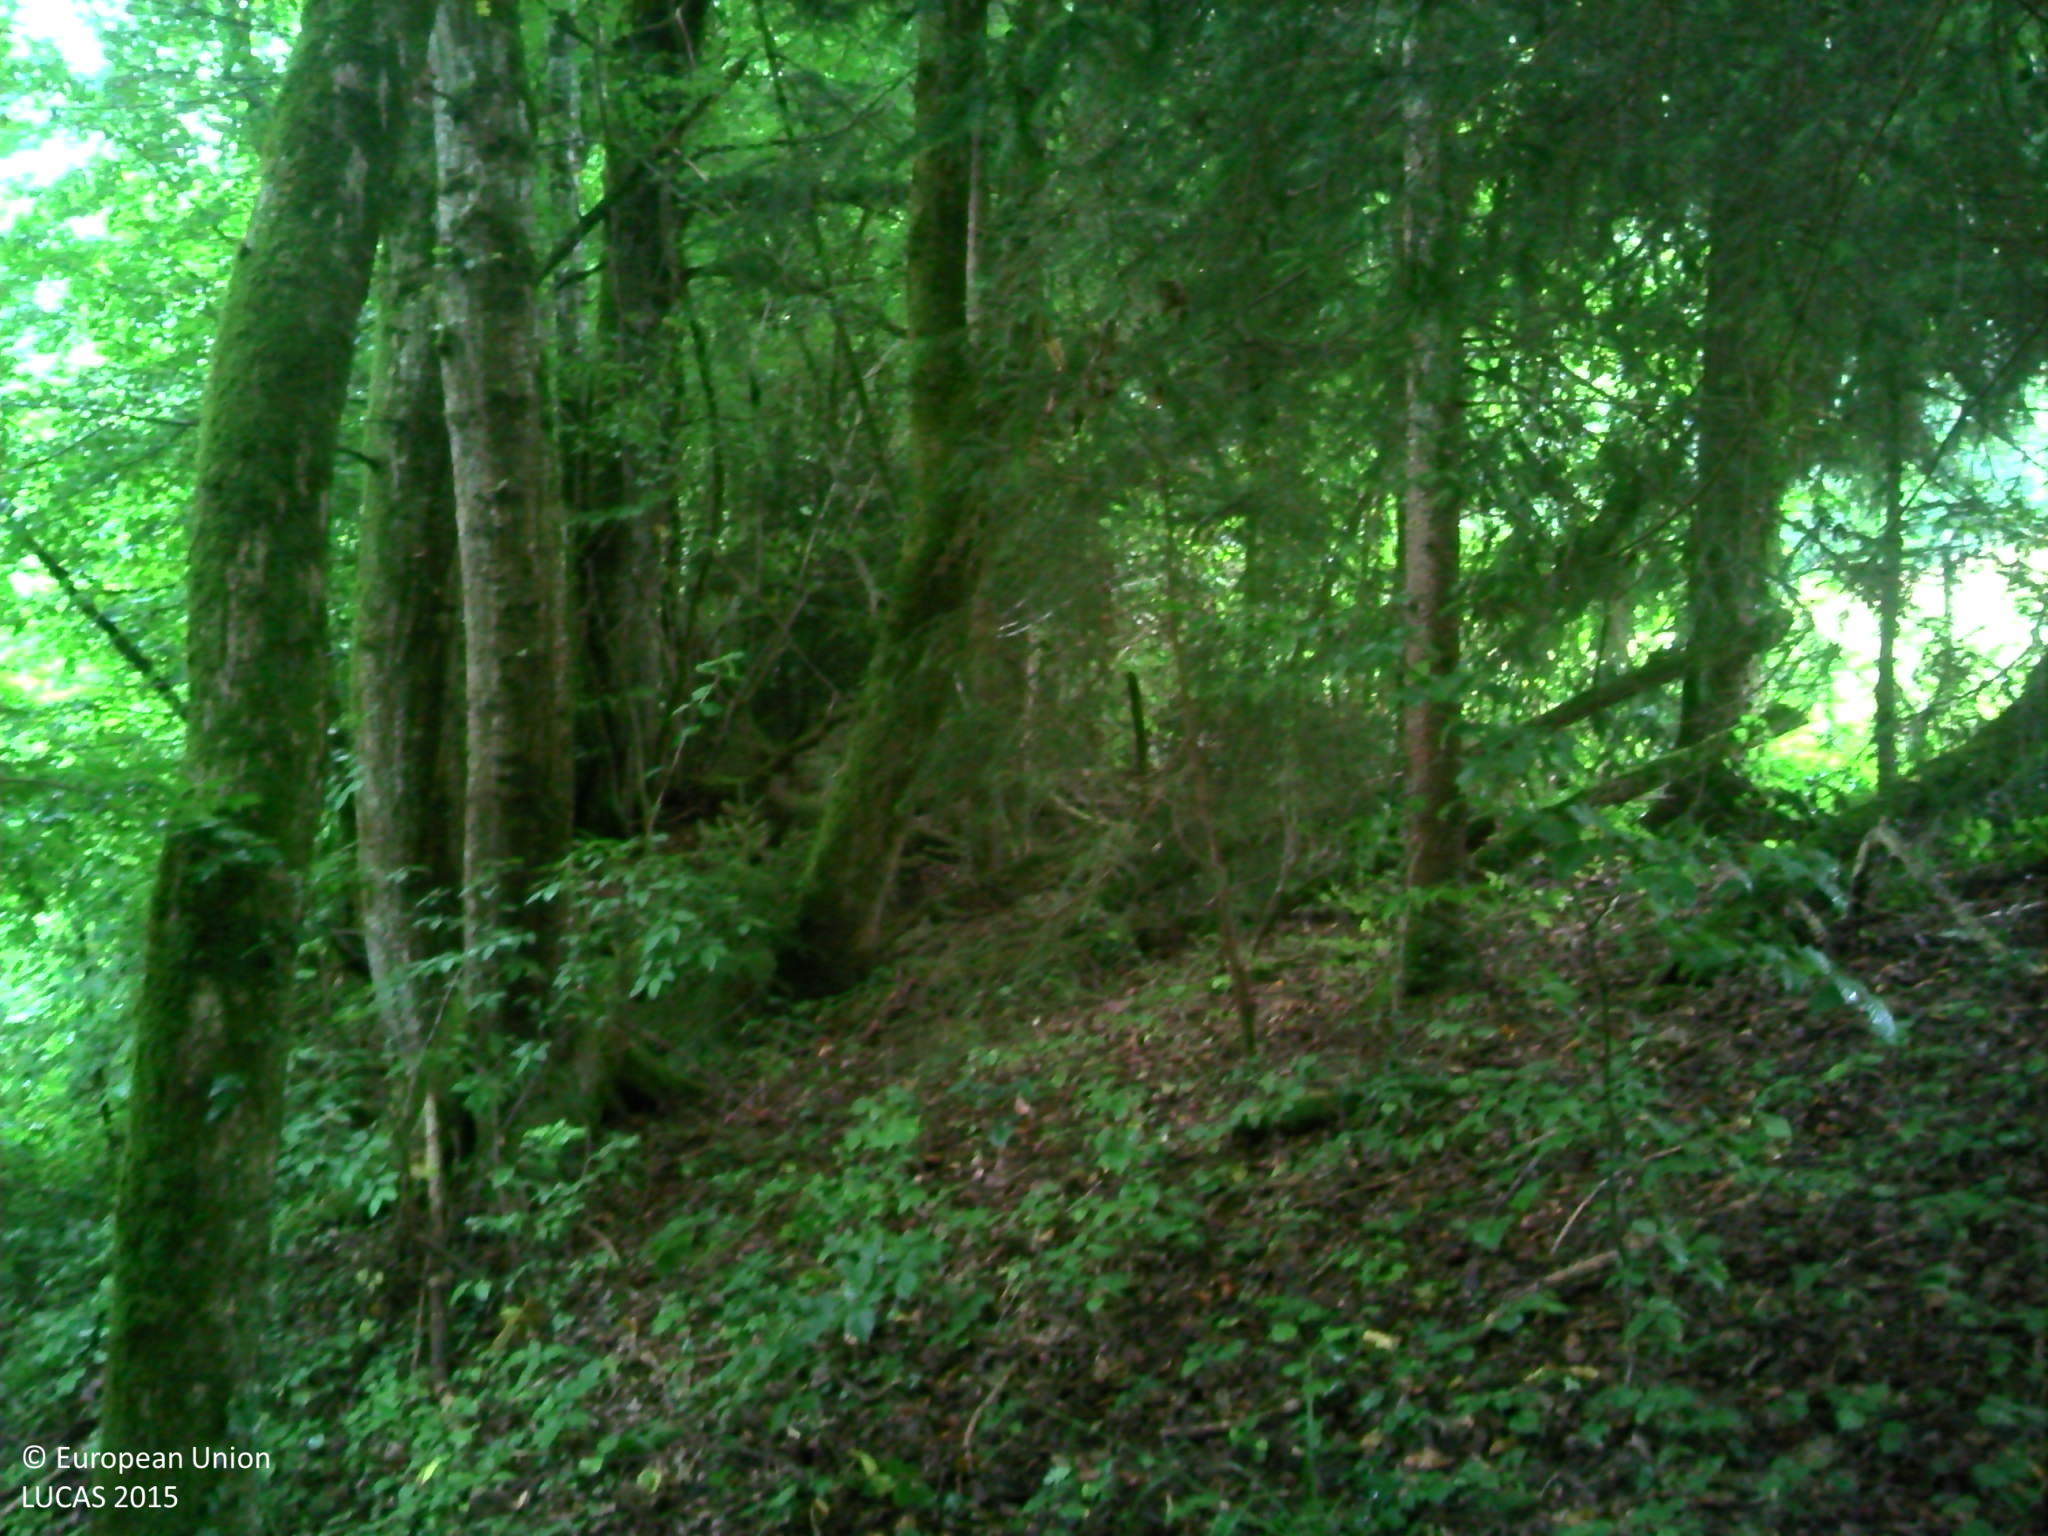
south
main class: Woodland
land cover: Broadleaved woodland
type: beech forest
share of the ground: > 75 %
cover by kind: broadleaved forest trees 65 %, coniferous forest trees 15 %, herbaceous plants 15 %, lichens and mosses 5 %
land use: Semi-natural and natural areas not in use
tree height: > 5 m
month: July
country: FR
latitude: 45.9770
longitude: 6.1963
